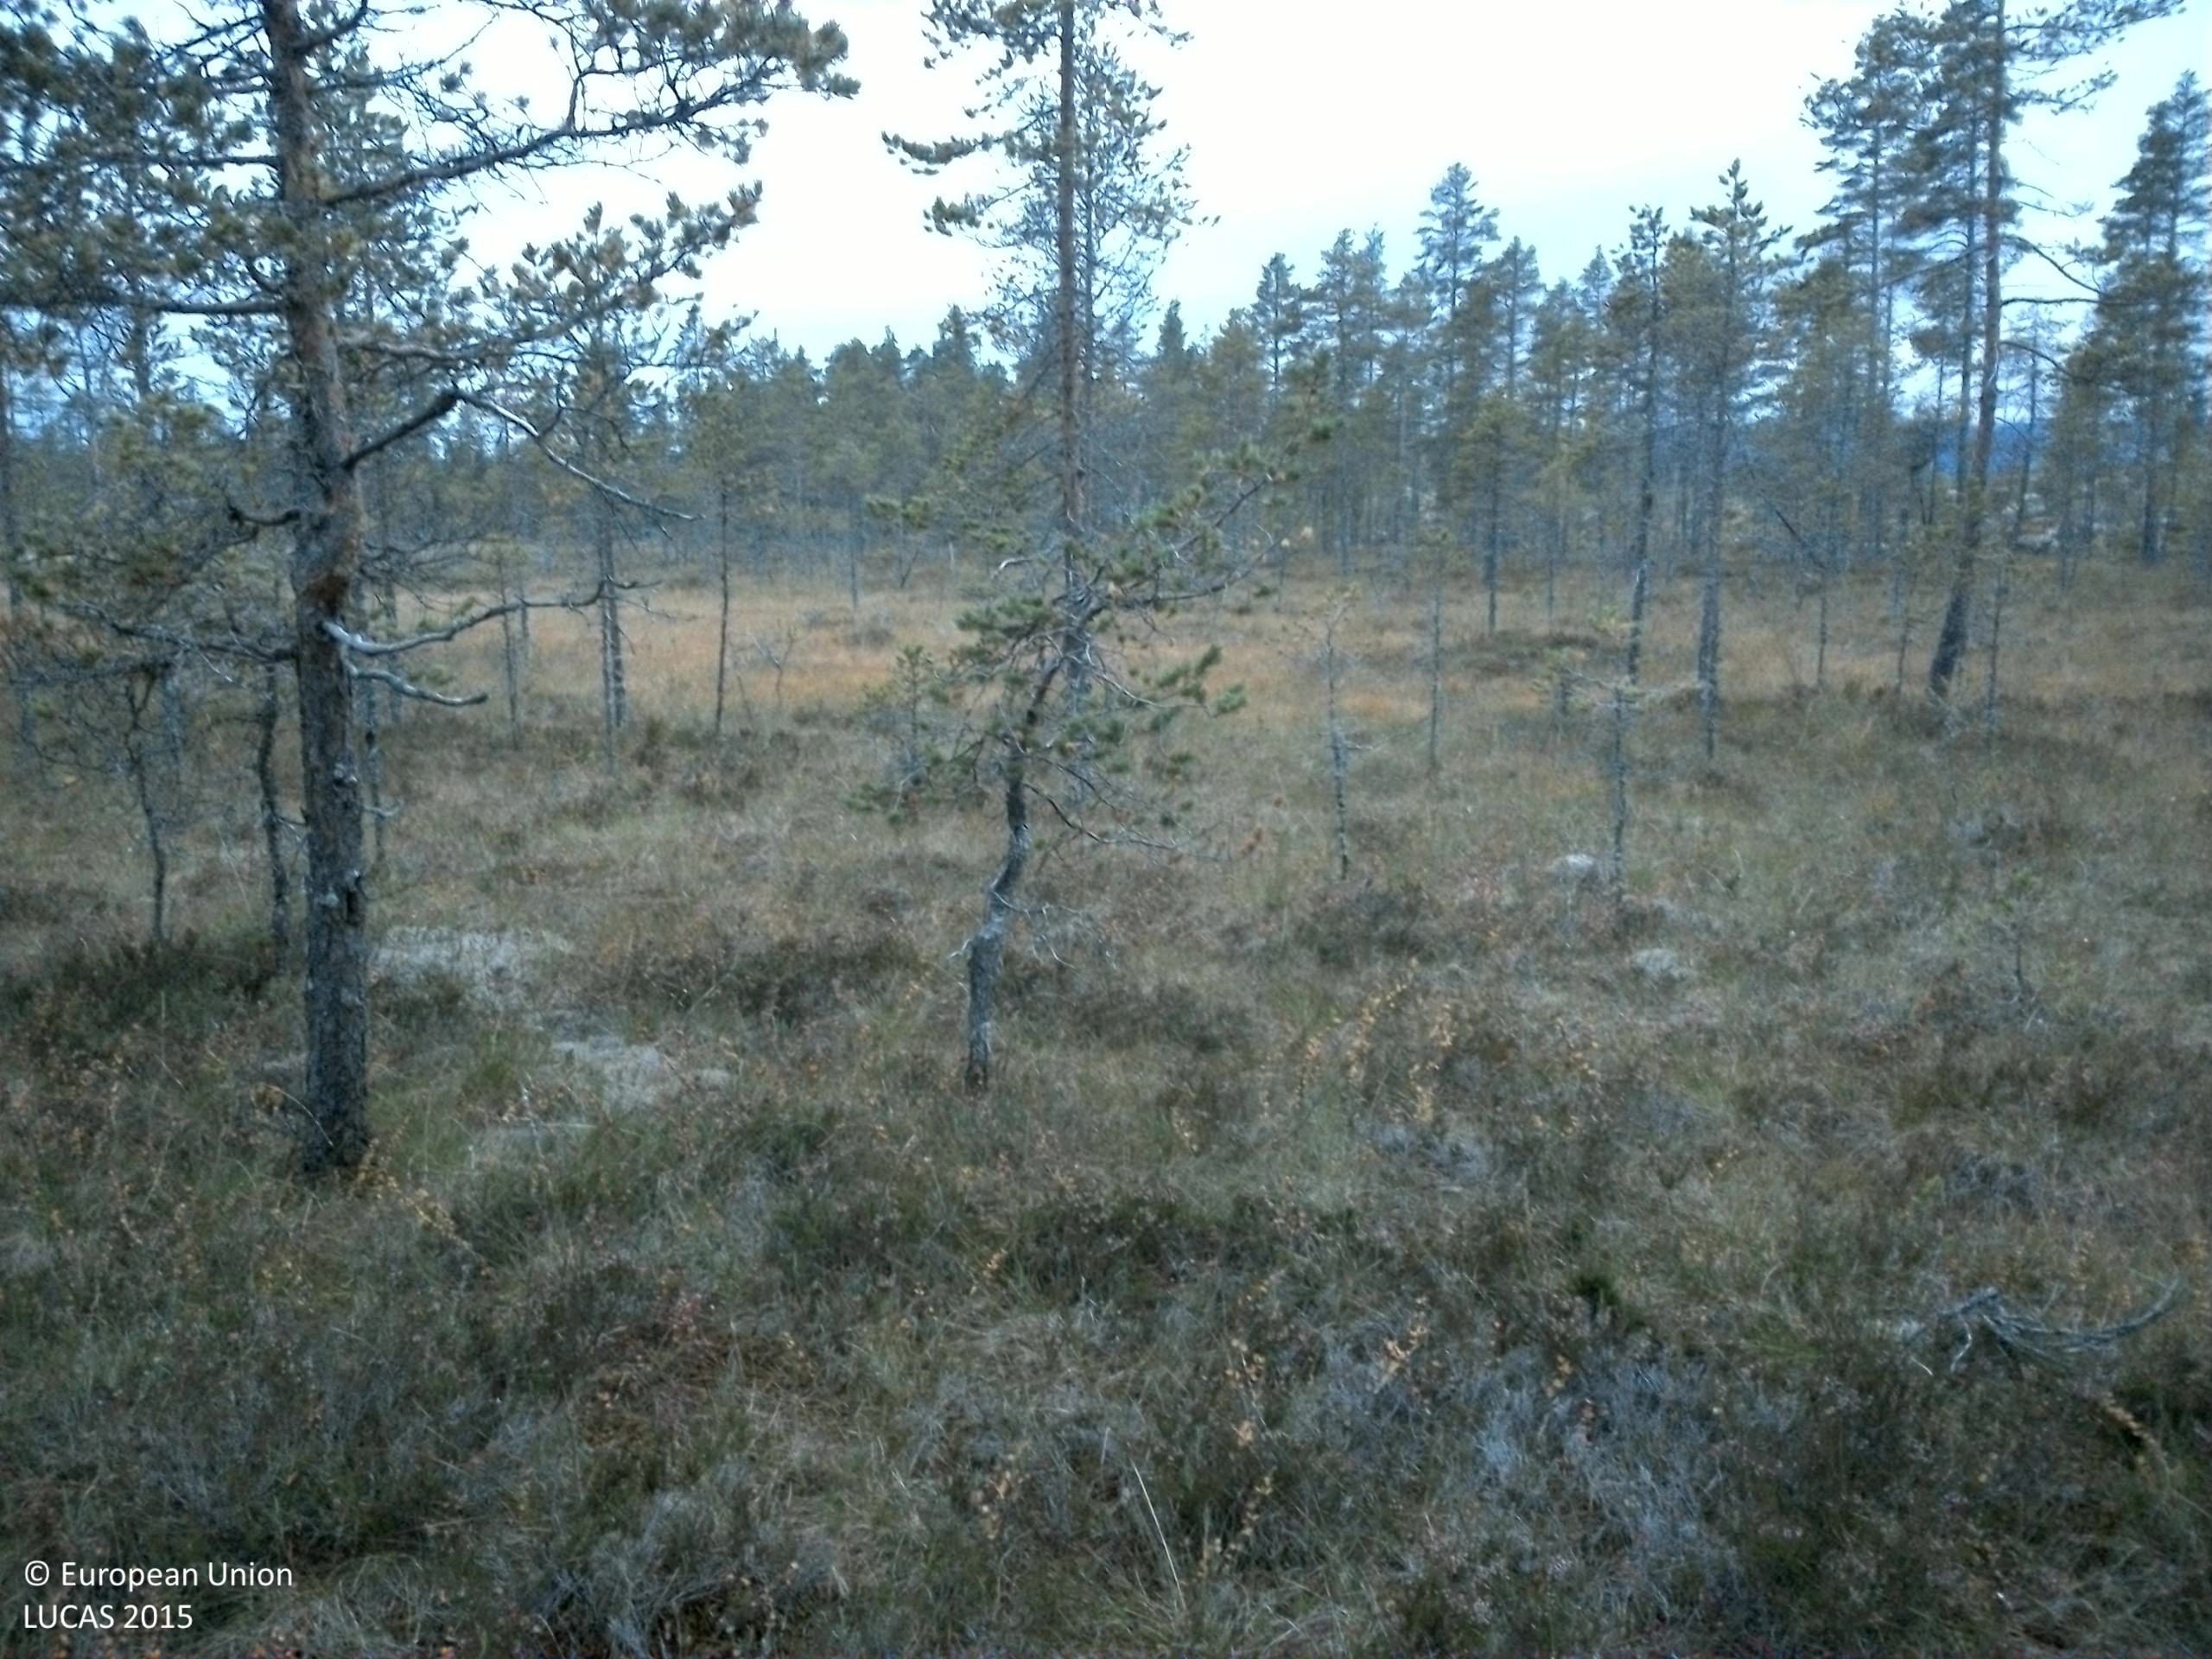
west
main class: Woodland
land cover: Pine dominated coniferous woodland
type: boreal forest
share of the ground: 10 - 25 %
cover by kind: shrubs 40 %, lichens and mosses 40 %, coniferous forest trees 20 %
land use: Forestry
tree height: > 5 m
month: September
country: SE
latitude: 61.6293
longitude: 14.9078
